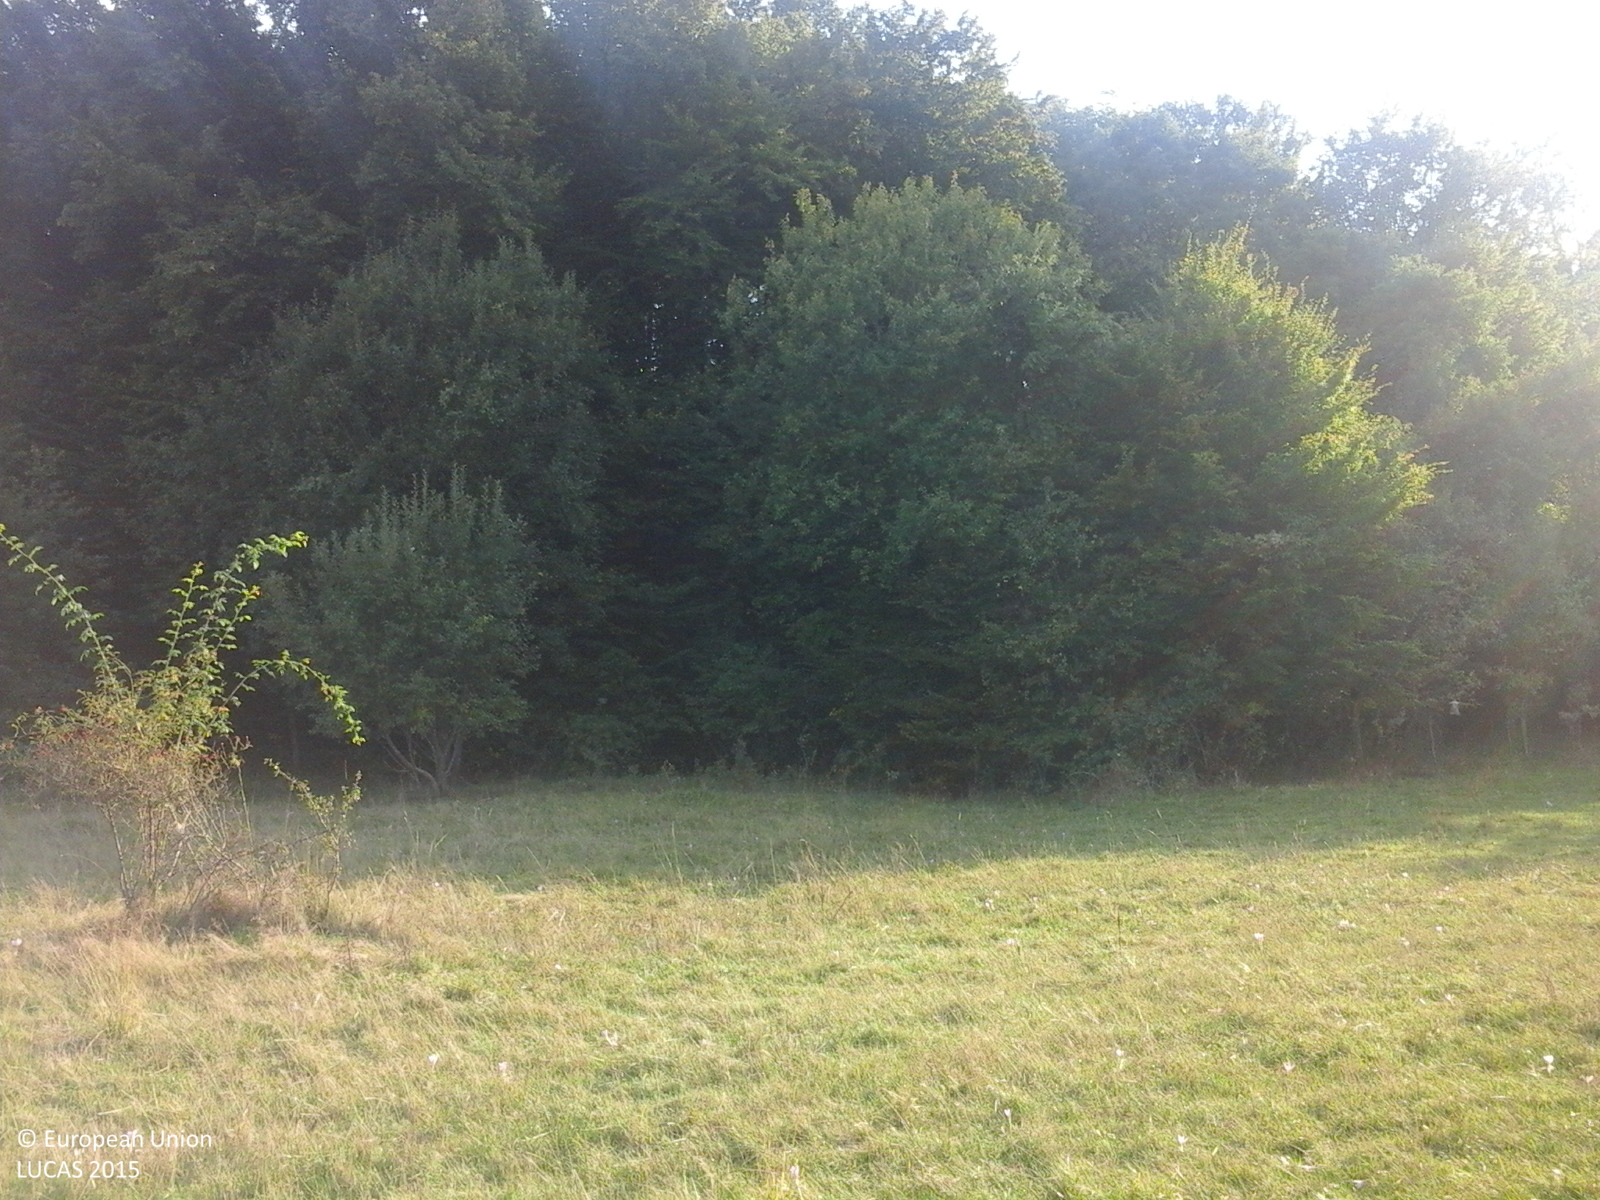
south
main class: Grassland
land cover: Grassland without tree/shrub cover
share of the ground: > 75 %
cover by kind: herbaceous plants 100 %
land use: Agriculture (excluding fallow land and kitchen gardens)
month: September
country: RO
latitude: 45.7732
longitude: 22.8480
